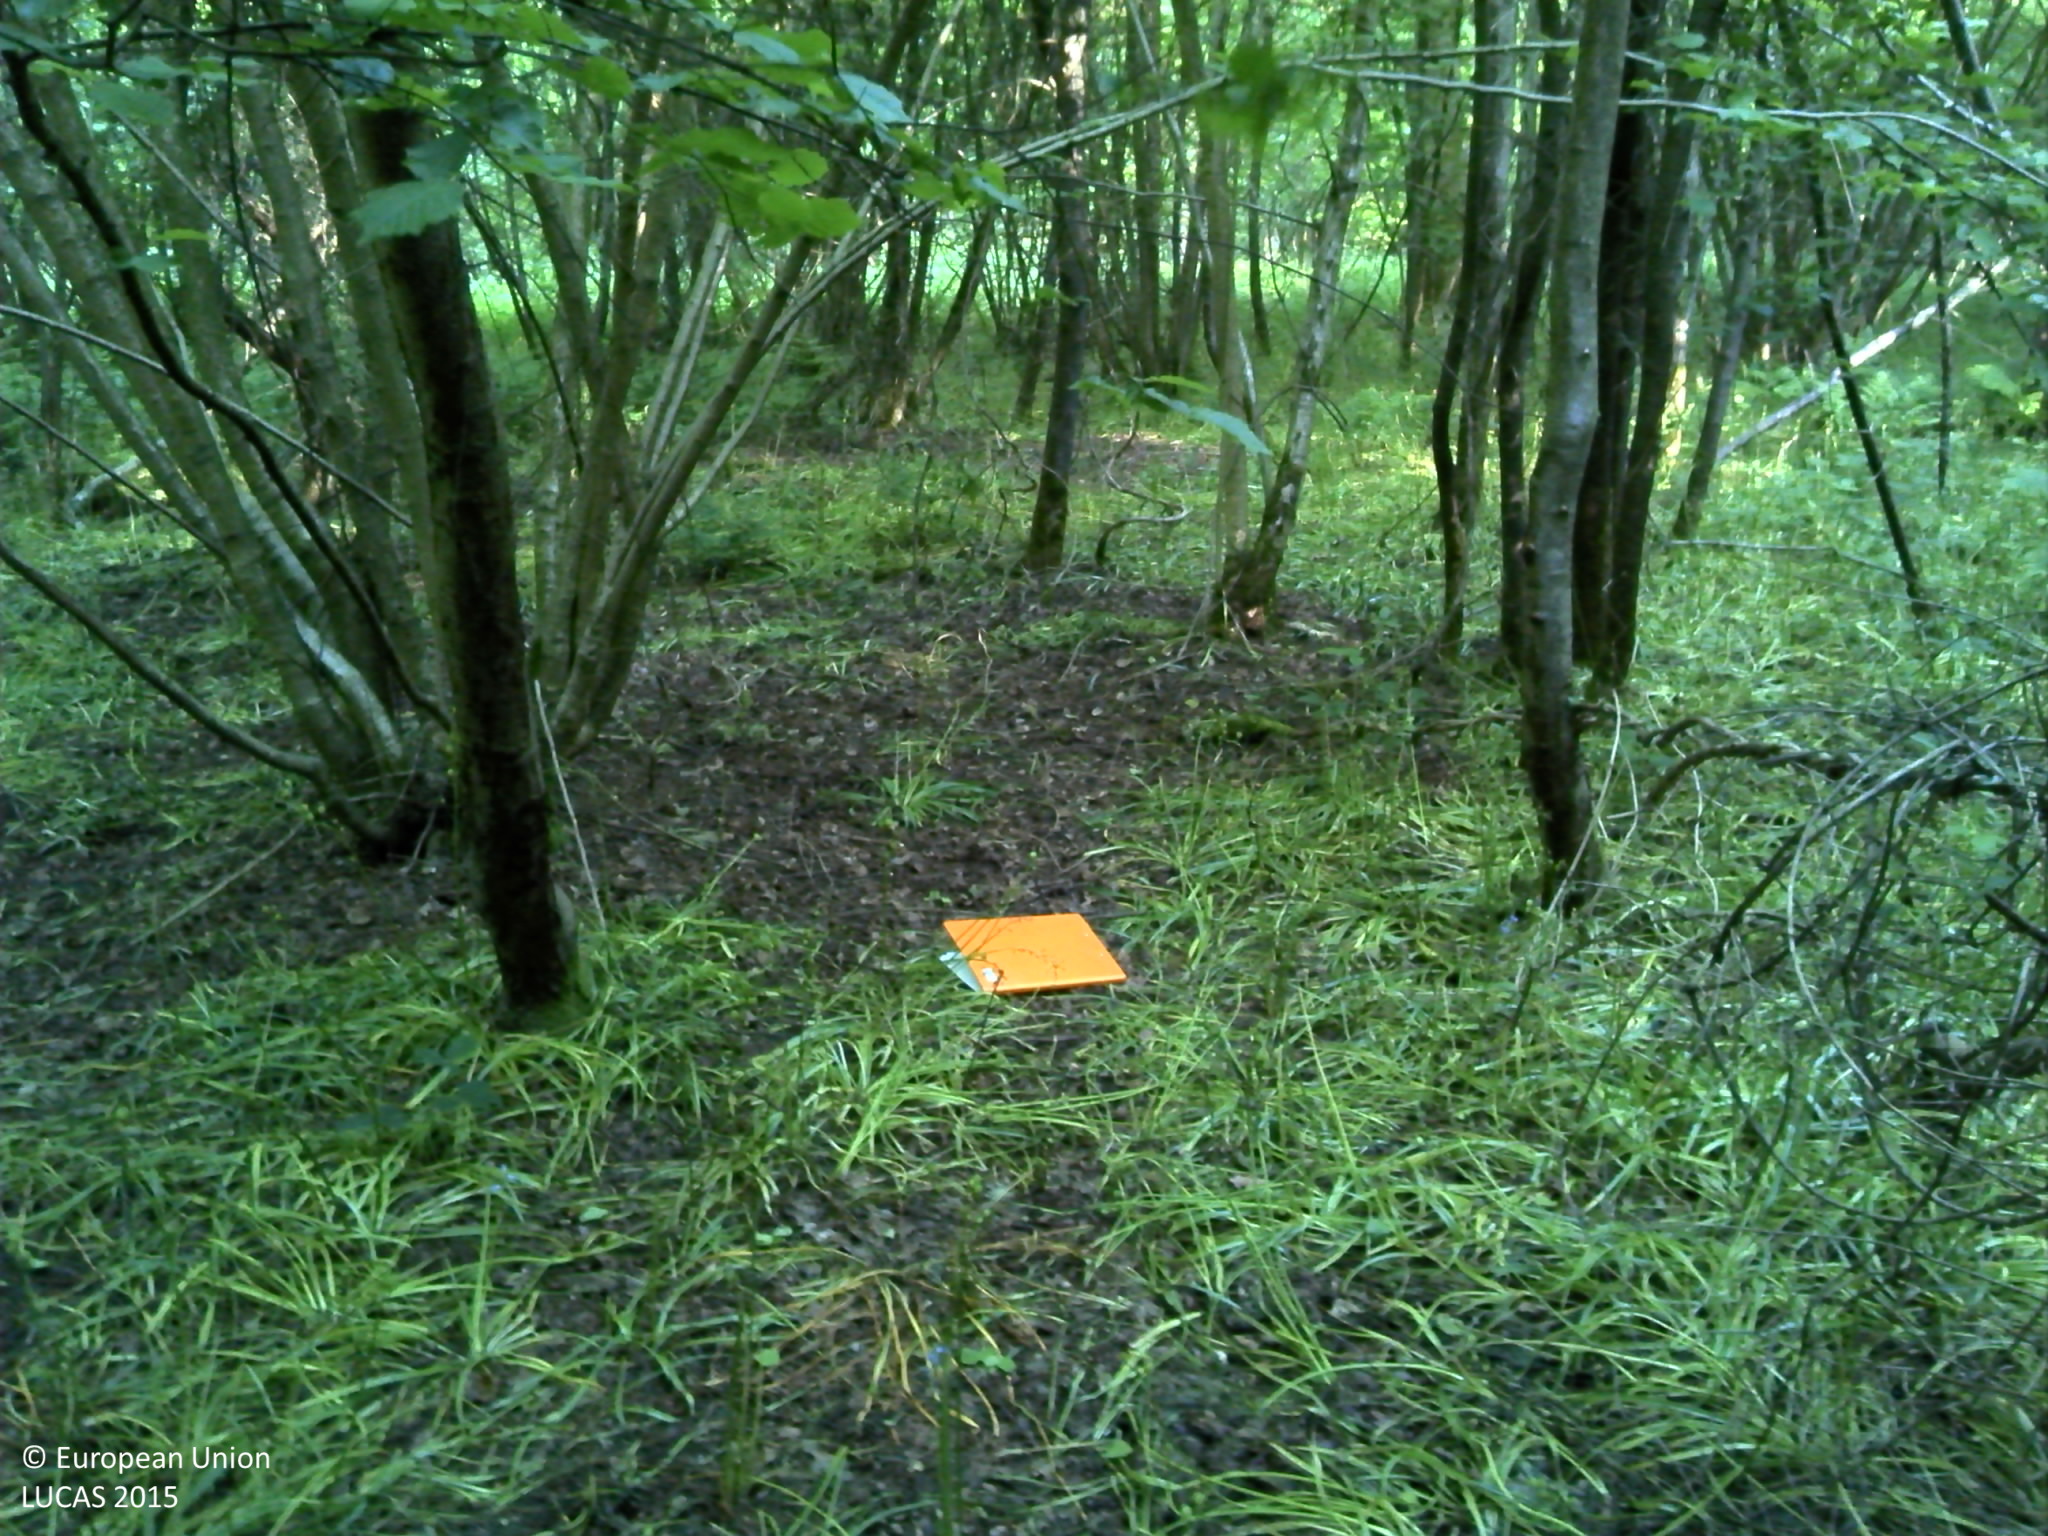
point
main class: Woodland
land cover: Broadleaved woodland
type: mesophytic deciduous forest
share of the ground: > 75 %
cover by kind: broadleaved forest trees 80 %, herbaceous plants 20 %
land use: Forestry
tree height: > 5 m
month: June
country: FR
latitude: 49.6946
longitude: 1.1478
